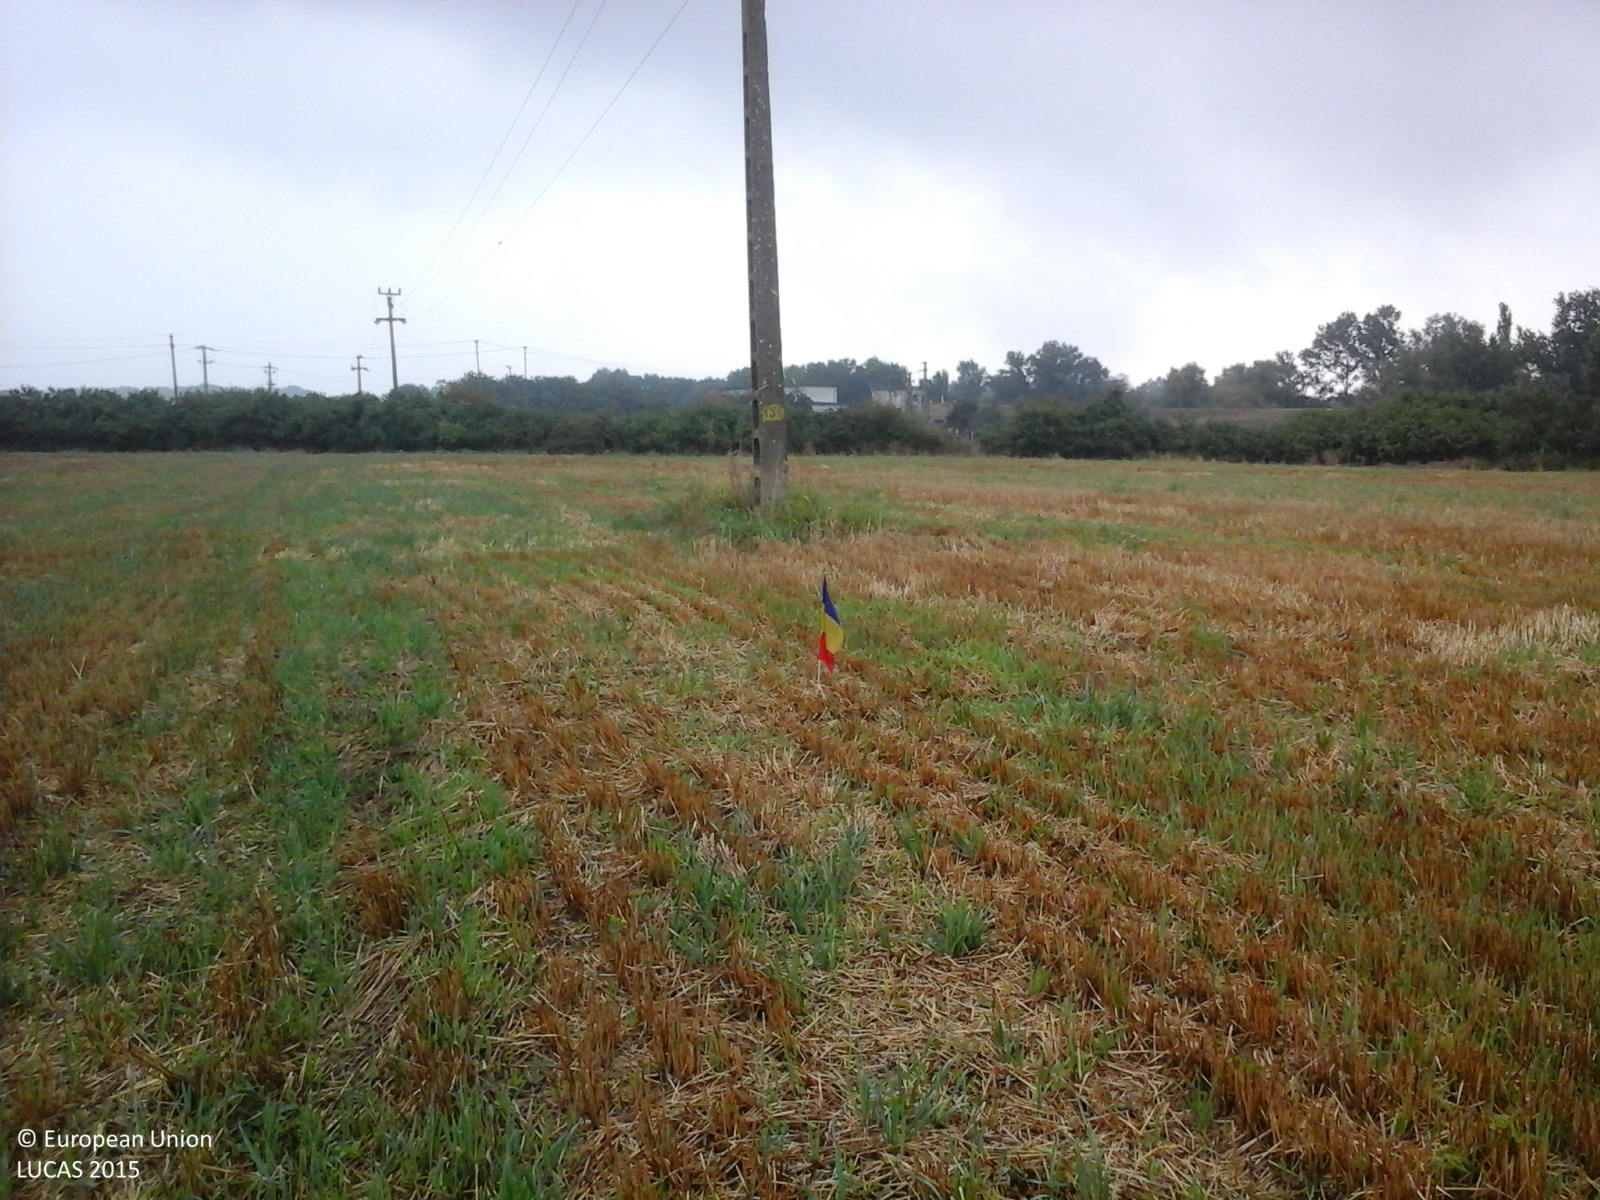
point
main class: Cropland
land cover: Durum wheat
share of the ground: < 10 %
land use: Agriculture (excluding fallow land and kitchen gardens)
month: August
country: RO
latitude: 46.1775
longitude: 20.5047
